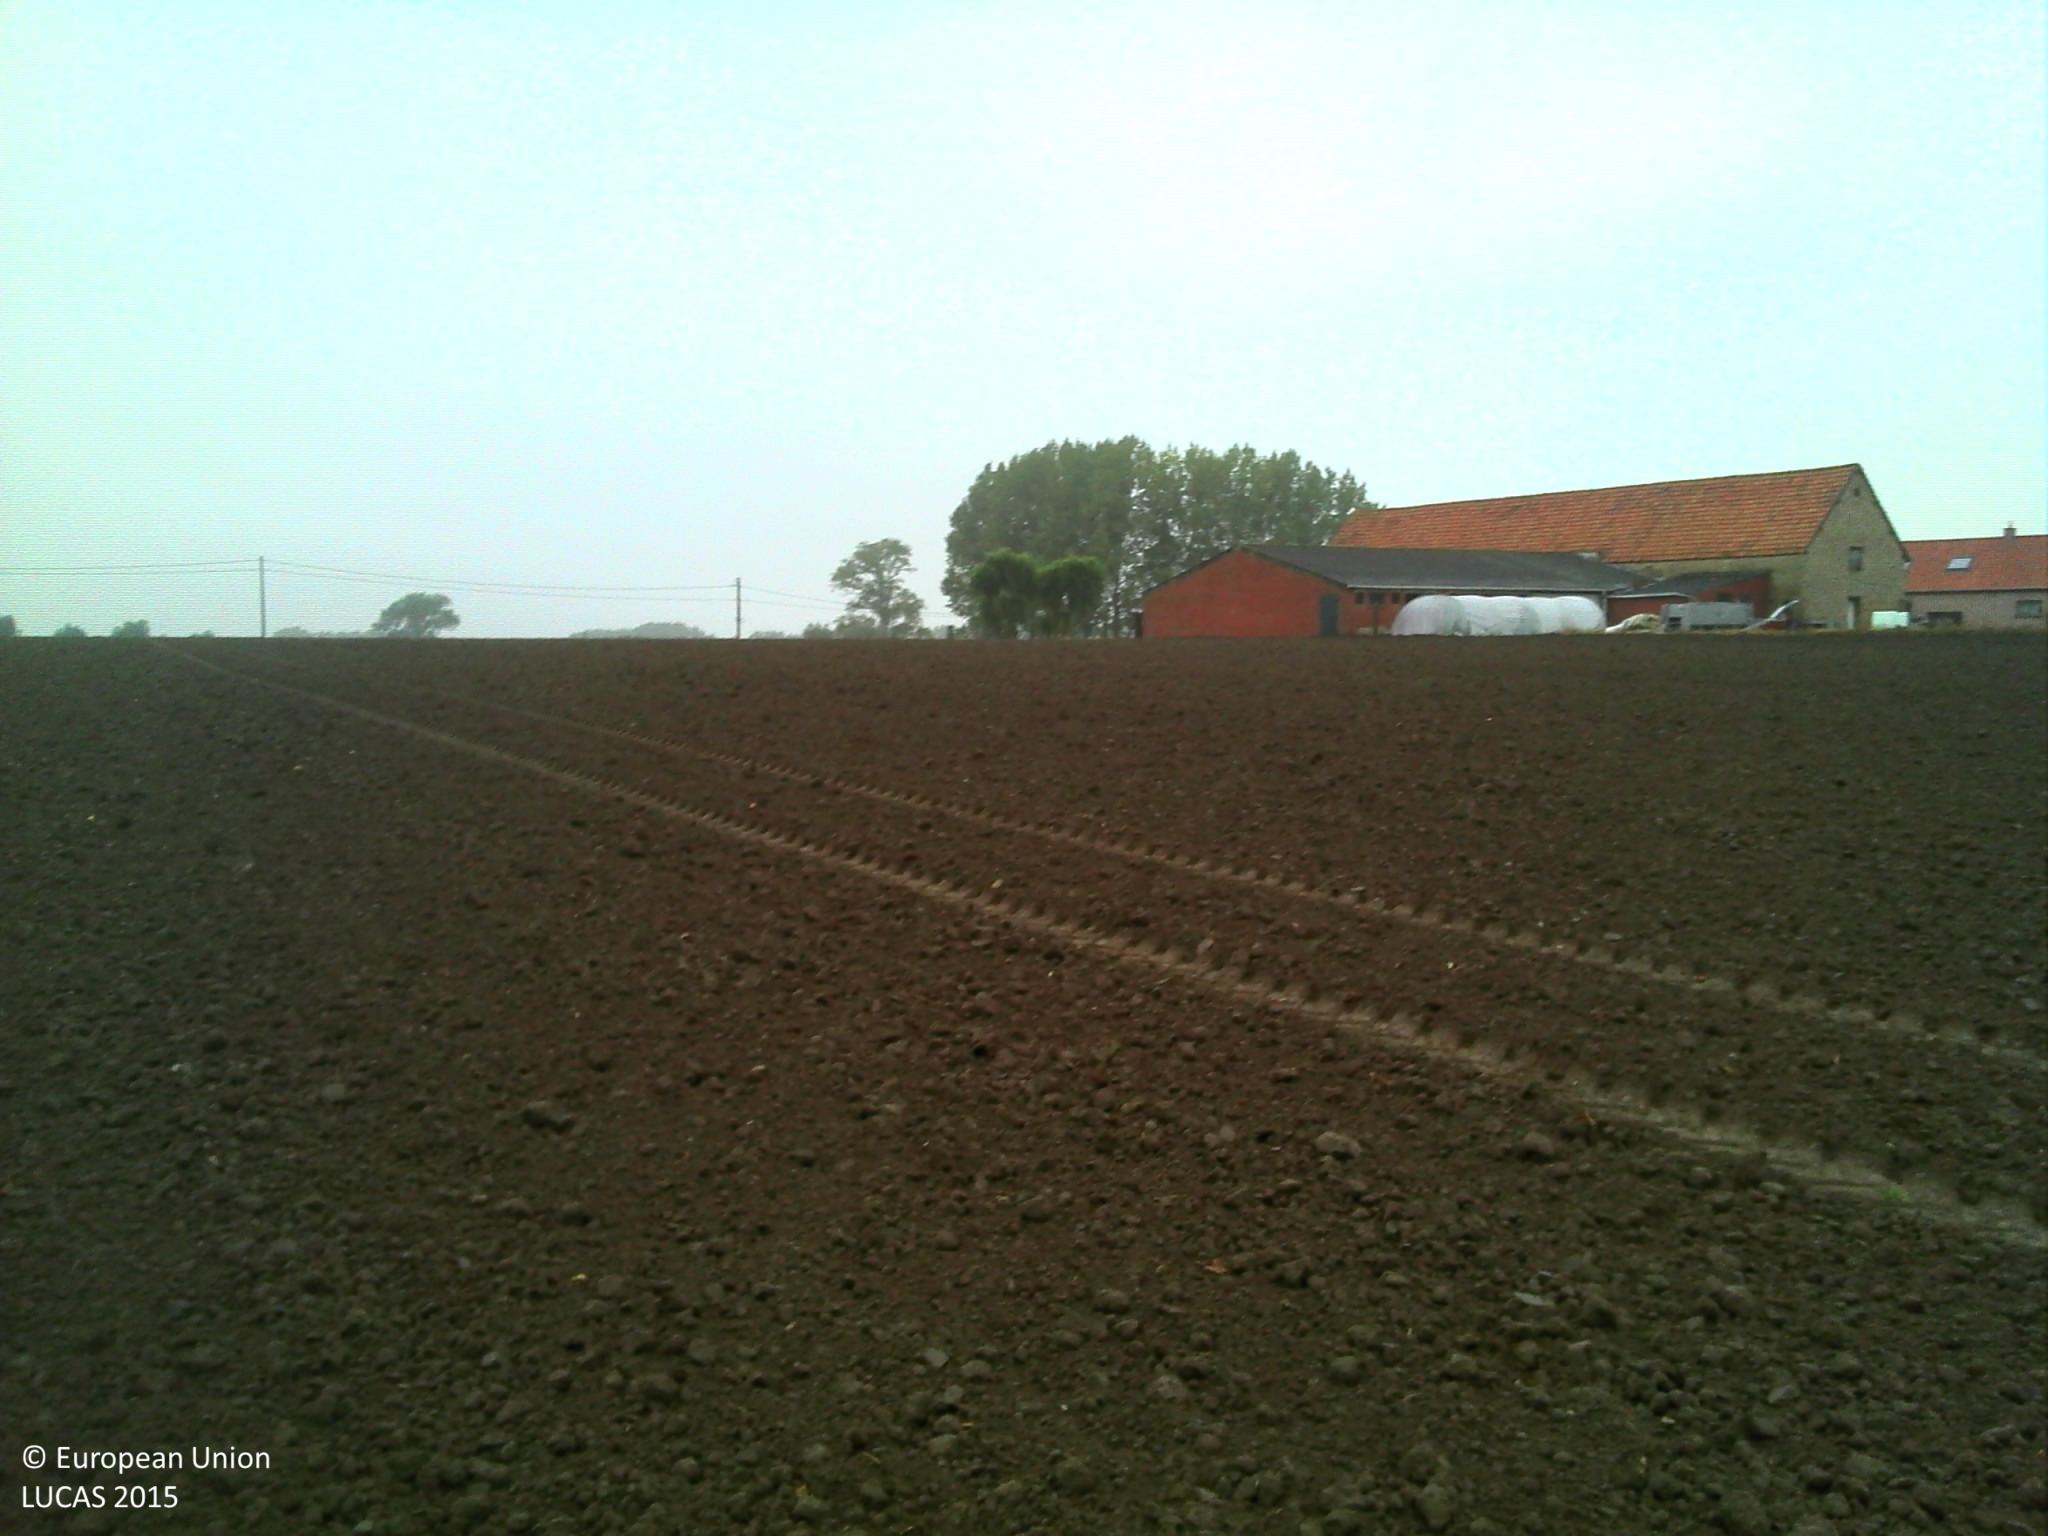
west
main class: Cropland
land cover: Barley
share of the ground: < 10 %
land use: Agriculture (excluding fallow land and kitchen gardens)
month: October
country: BE
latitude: 51.0101
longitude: 2.9058
